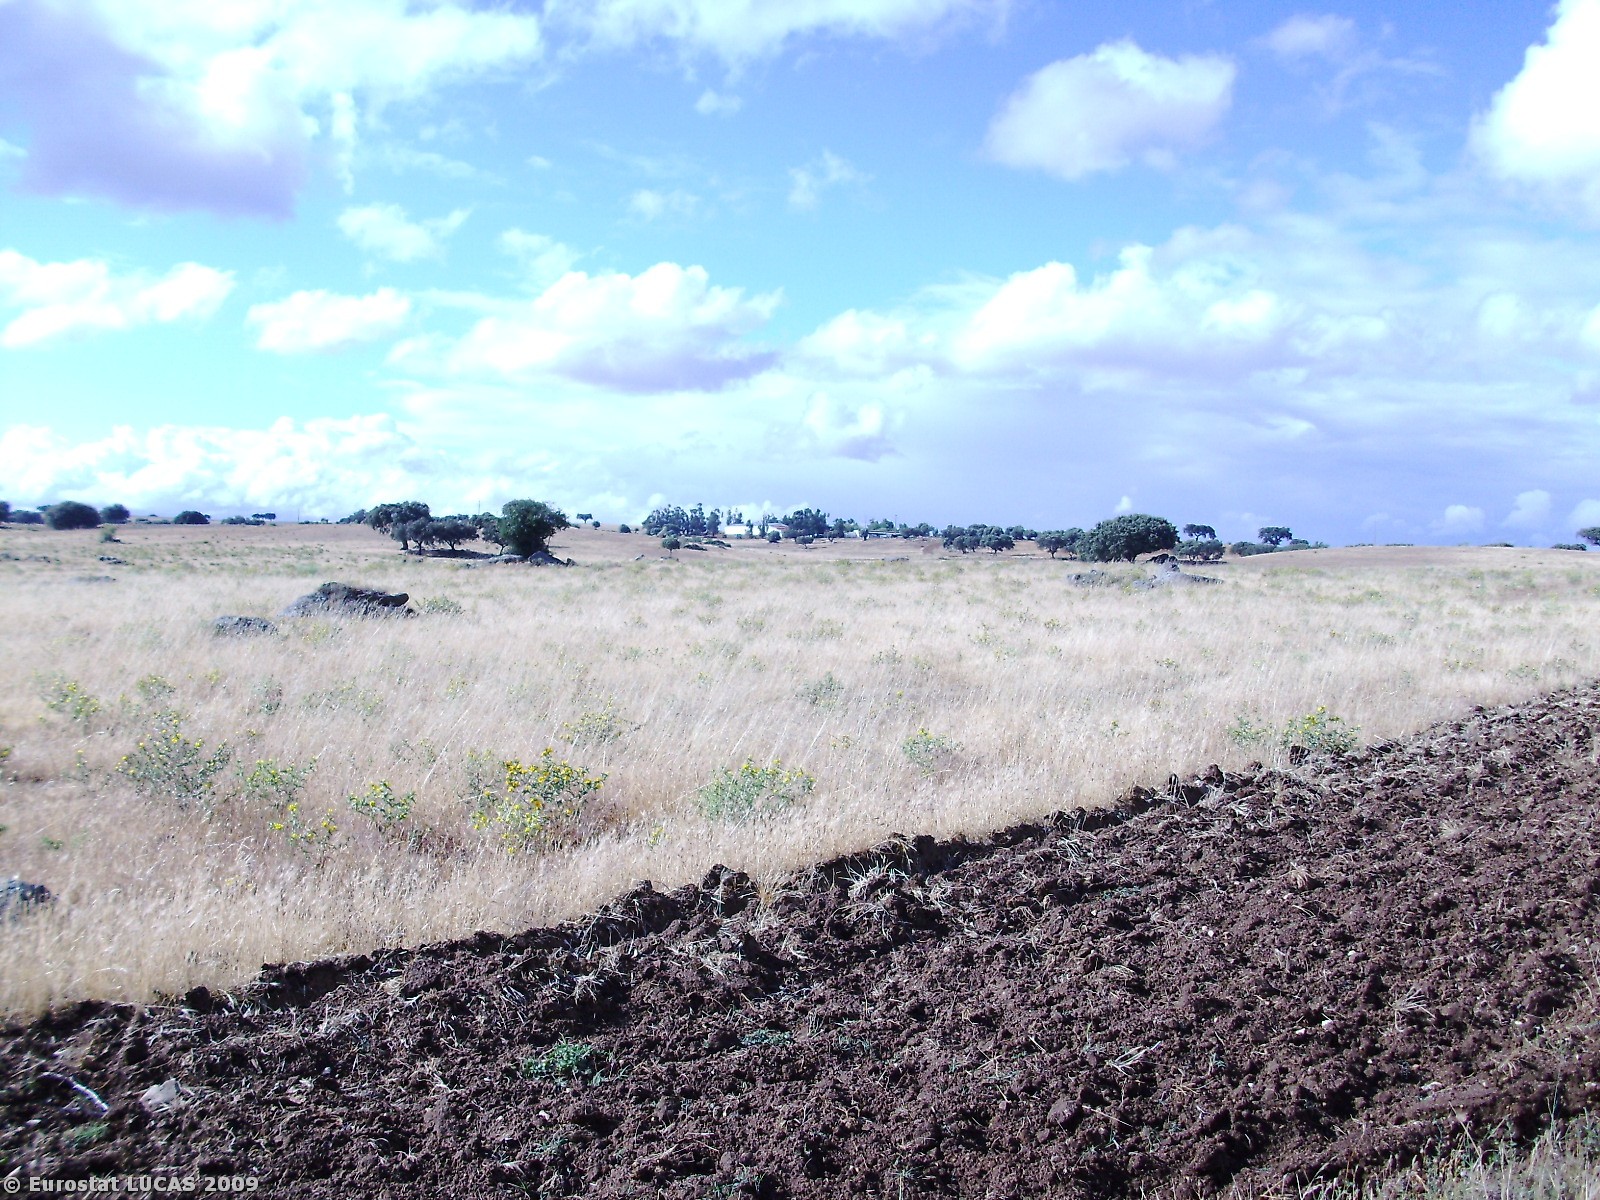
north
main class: Grassland
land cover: Spontaneously vegetated surfaces
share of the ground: > 75 %
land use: Fallow land
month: June
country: PT
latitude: 39.0819
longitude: -7.2227
